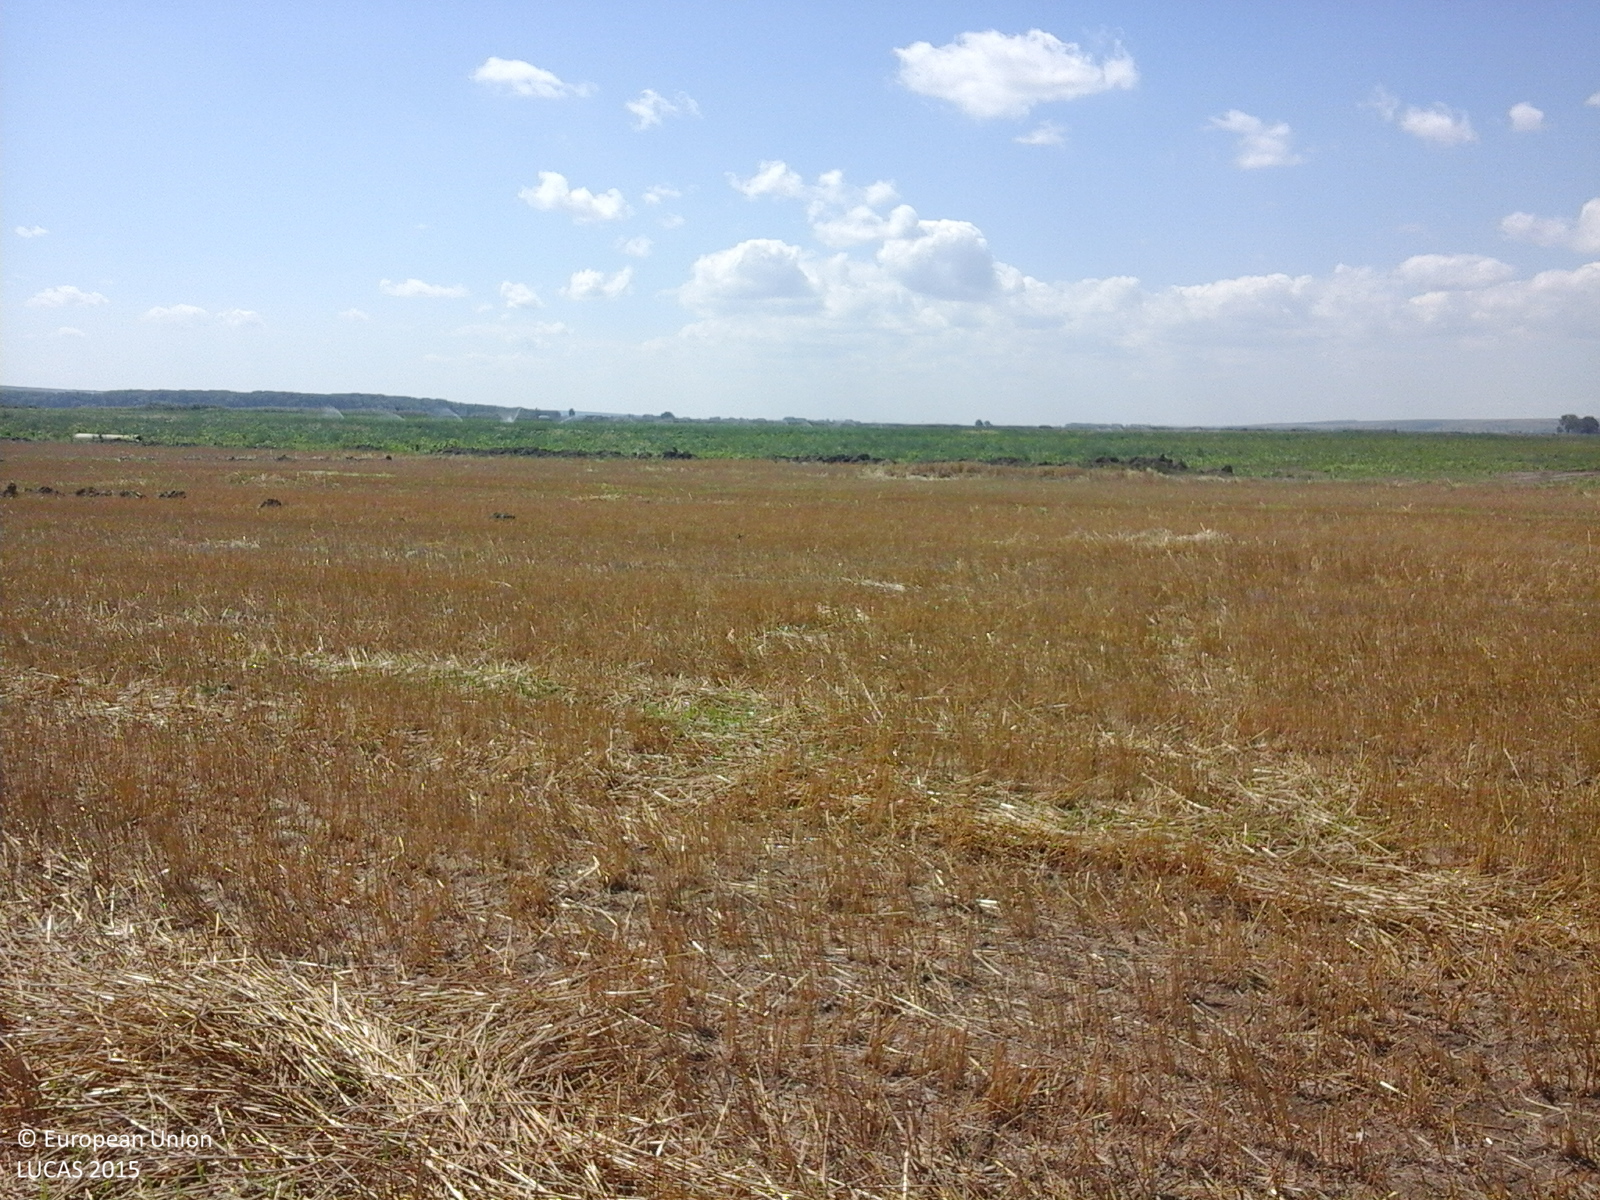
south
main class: Cropland
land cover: Common wheat
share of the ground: 50 - 75 %
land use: Agriculture (excluding fallow land and kitchen gardens)
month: July
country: RO
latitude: 46.3964
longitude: 28.1968
